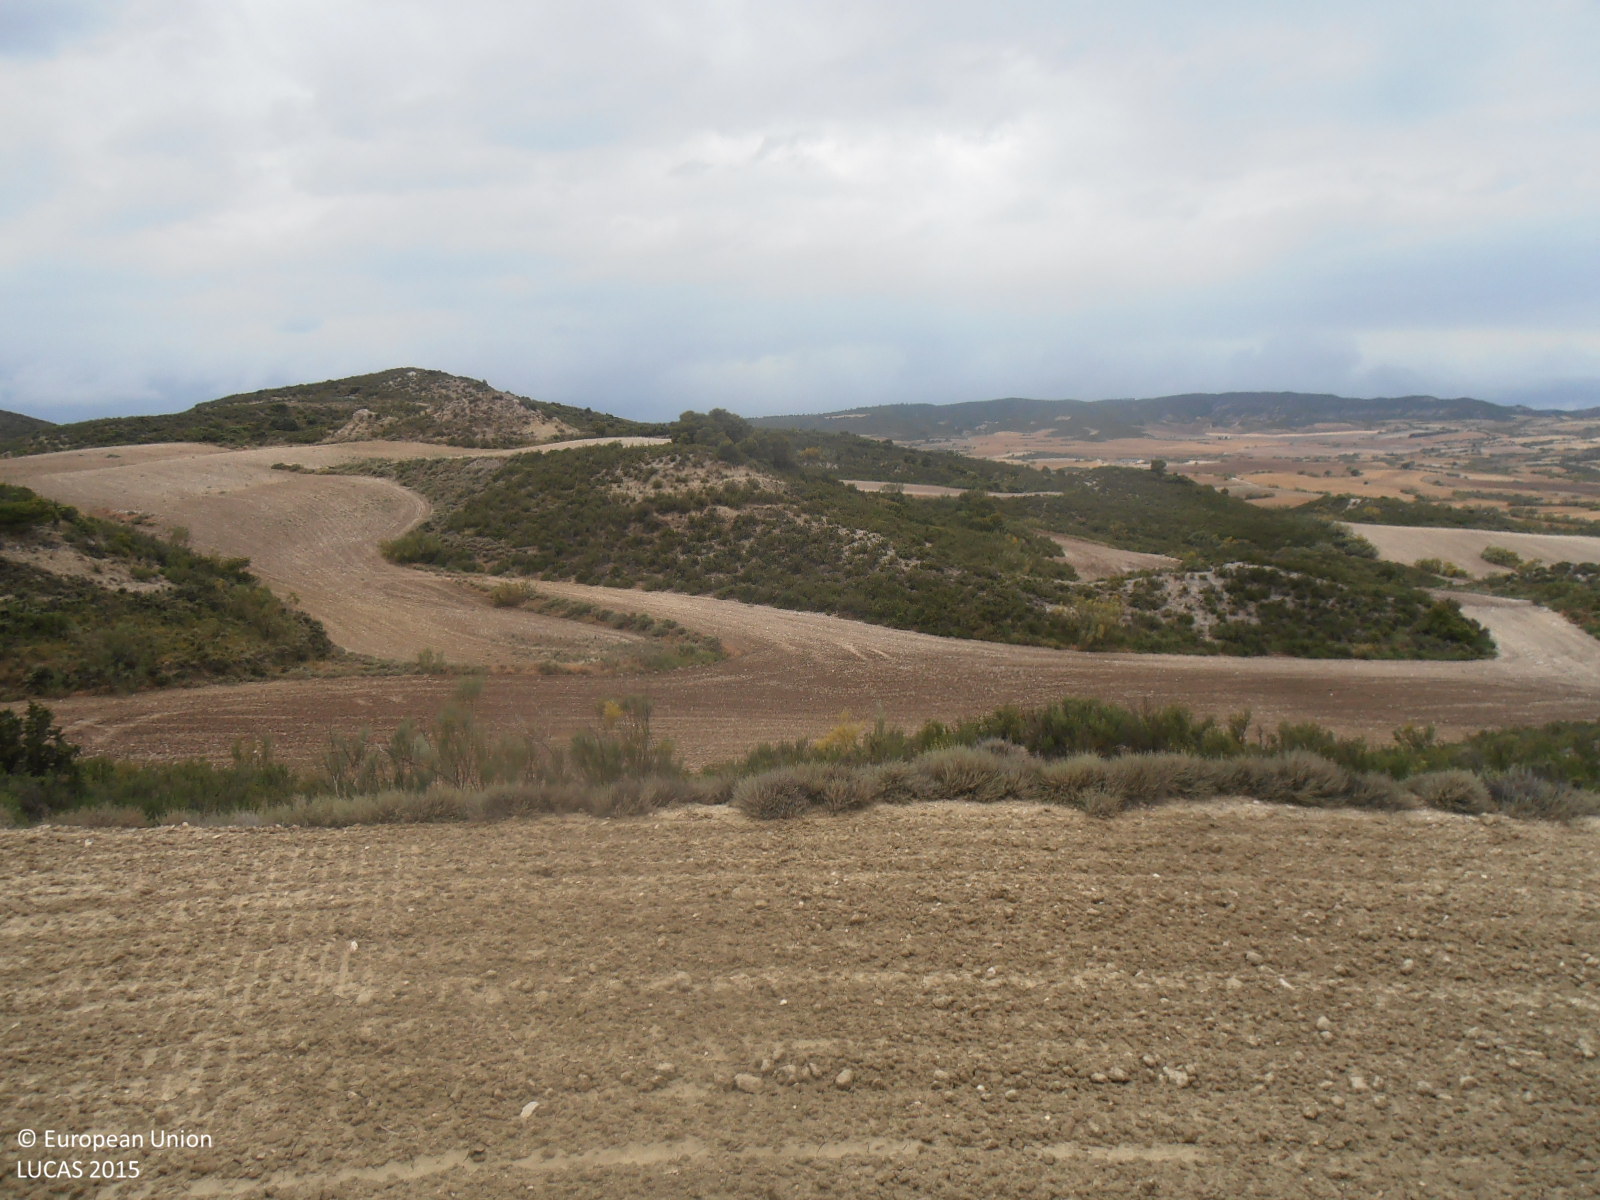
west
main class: Shrubland
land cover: Shrubland without tree cover
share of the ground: 50 - 75 %
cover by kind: shrubs 55 %, consolidated bare surface 45 %
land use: Semi-natural and natural areas not in use
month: June
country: ES
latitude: 41.9069
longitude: -0.8373
